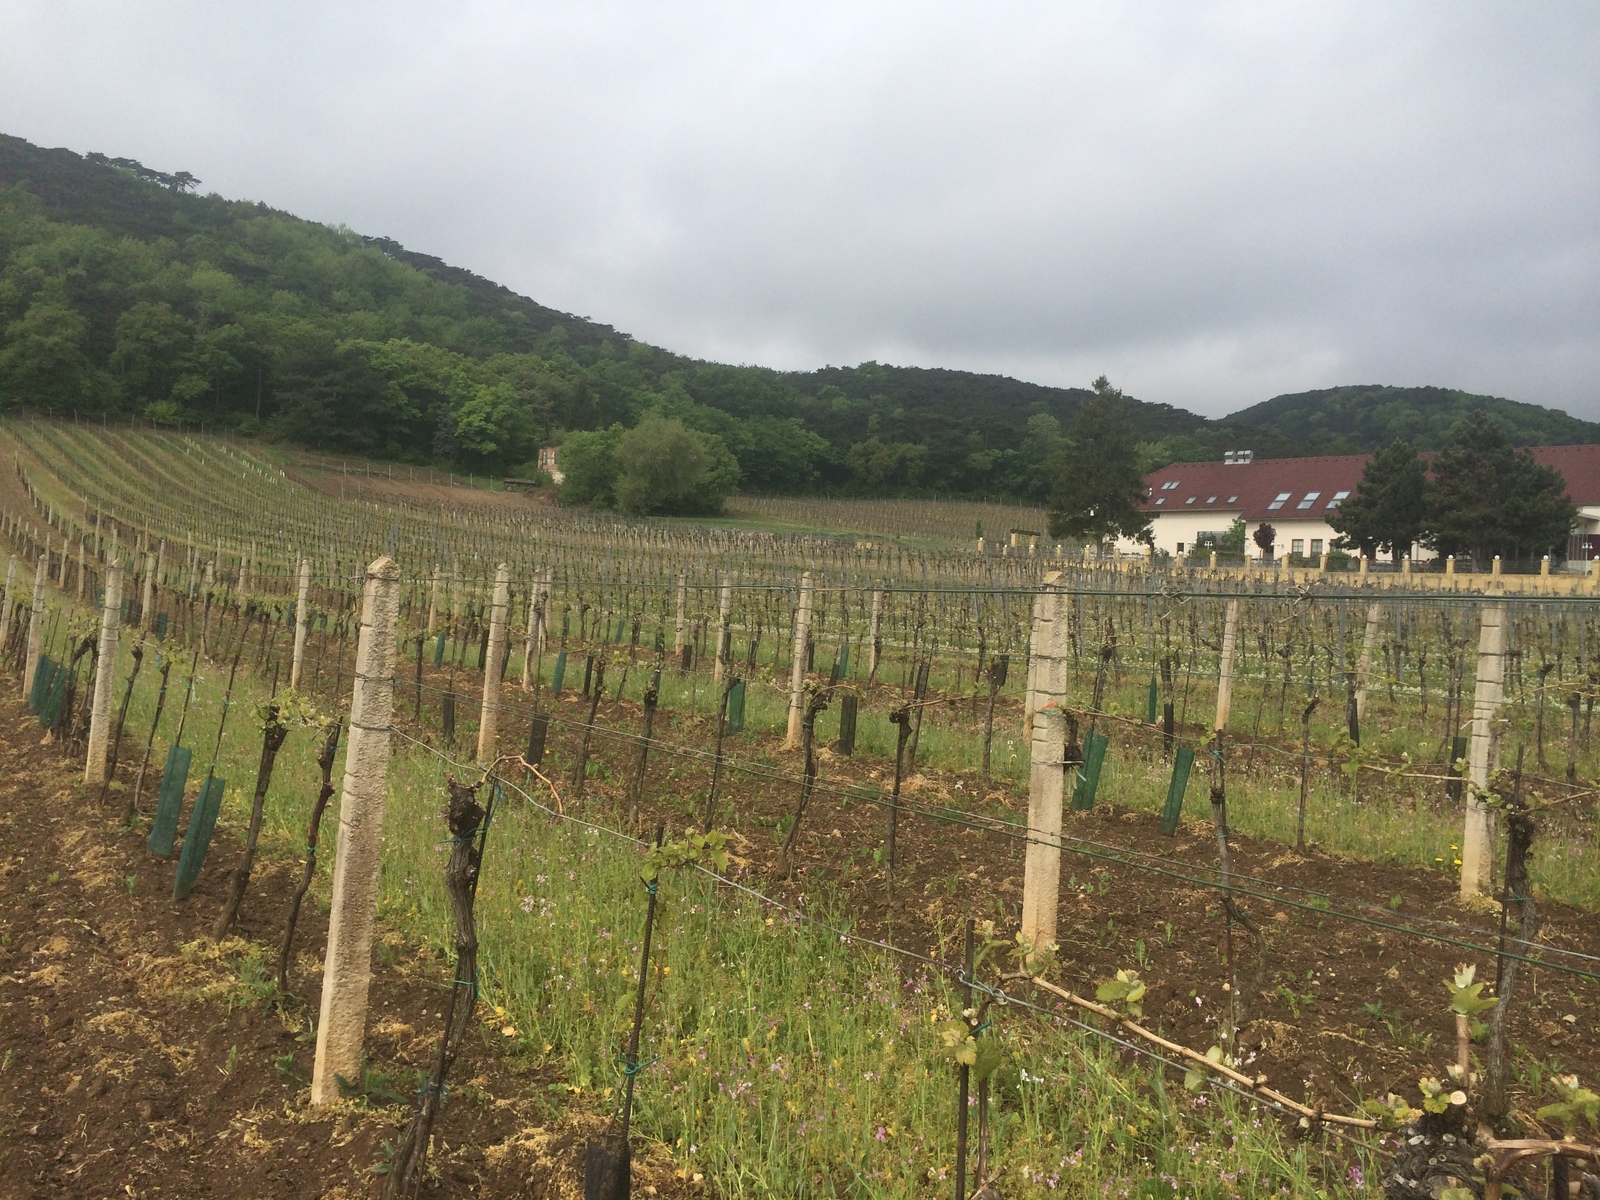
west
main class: Cropland
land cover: Vineyards
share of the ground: > 75 %
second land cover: Grassland without tree/shrub cover
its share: > 75 %
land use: Agriculture (excluding fallow land and kitchen gardens)
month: May
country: AT
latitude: 47.9765
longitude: 16.2065
